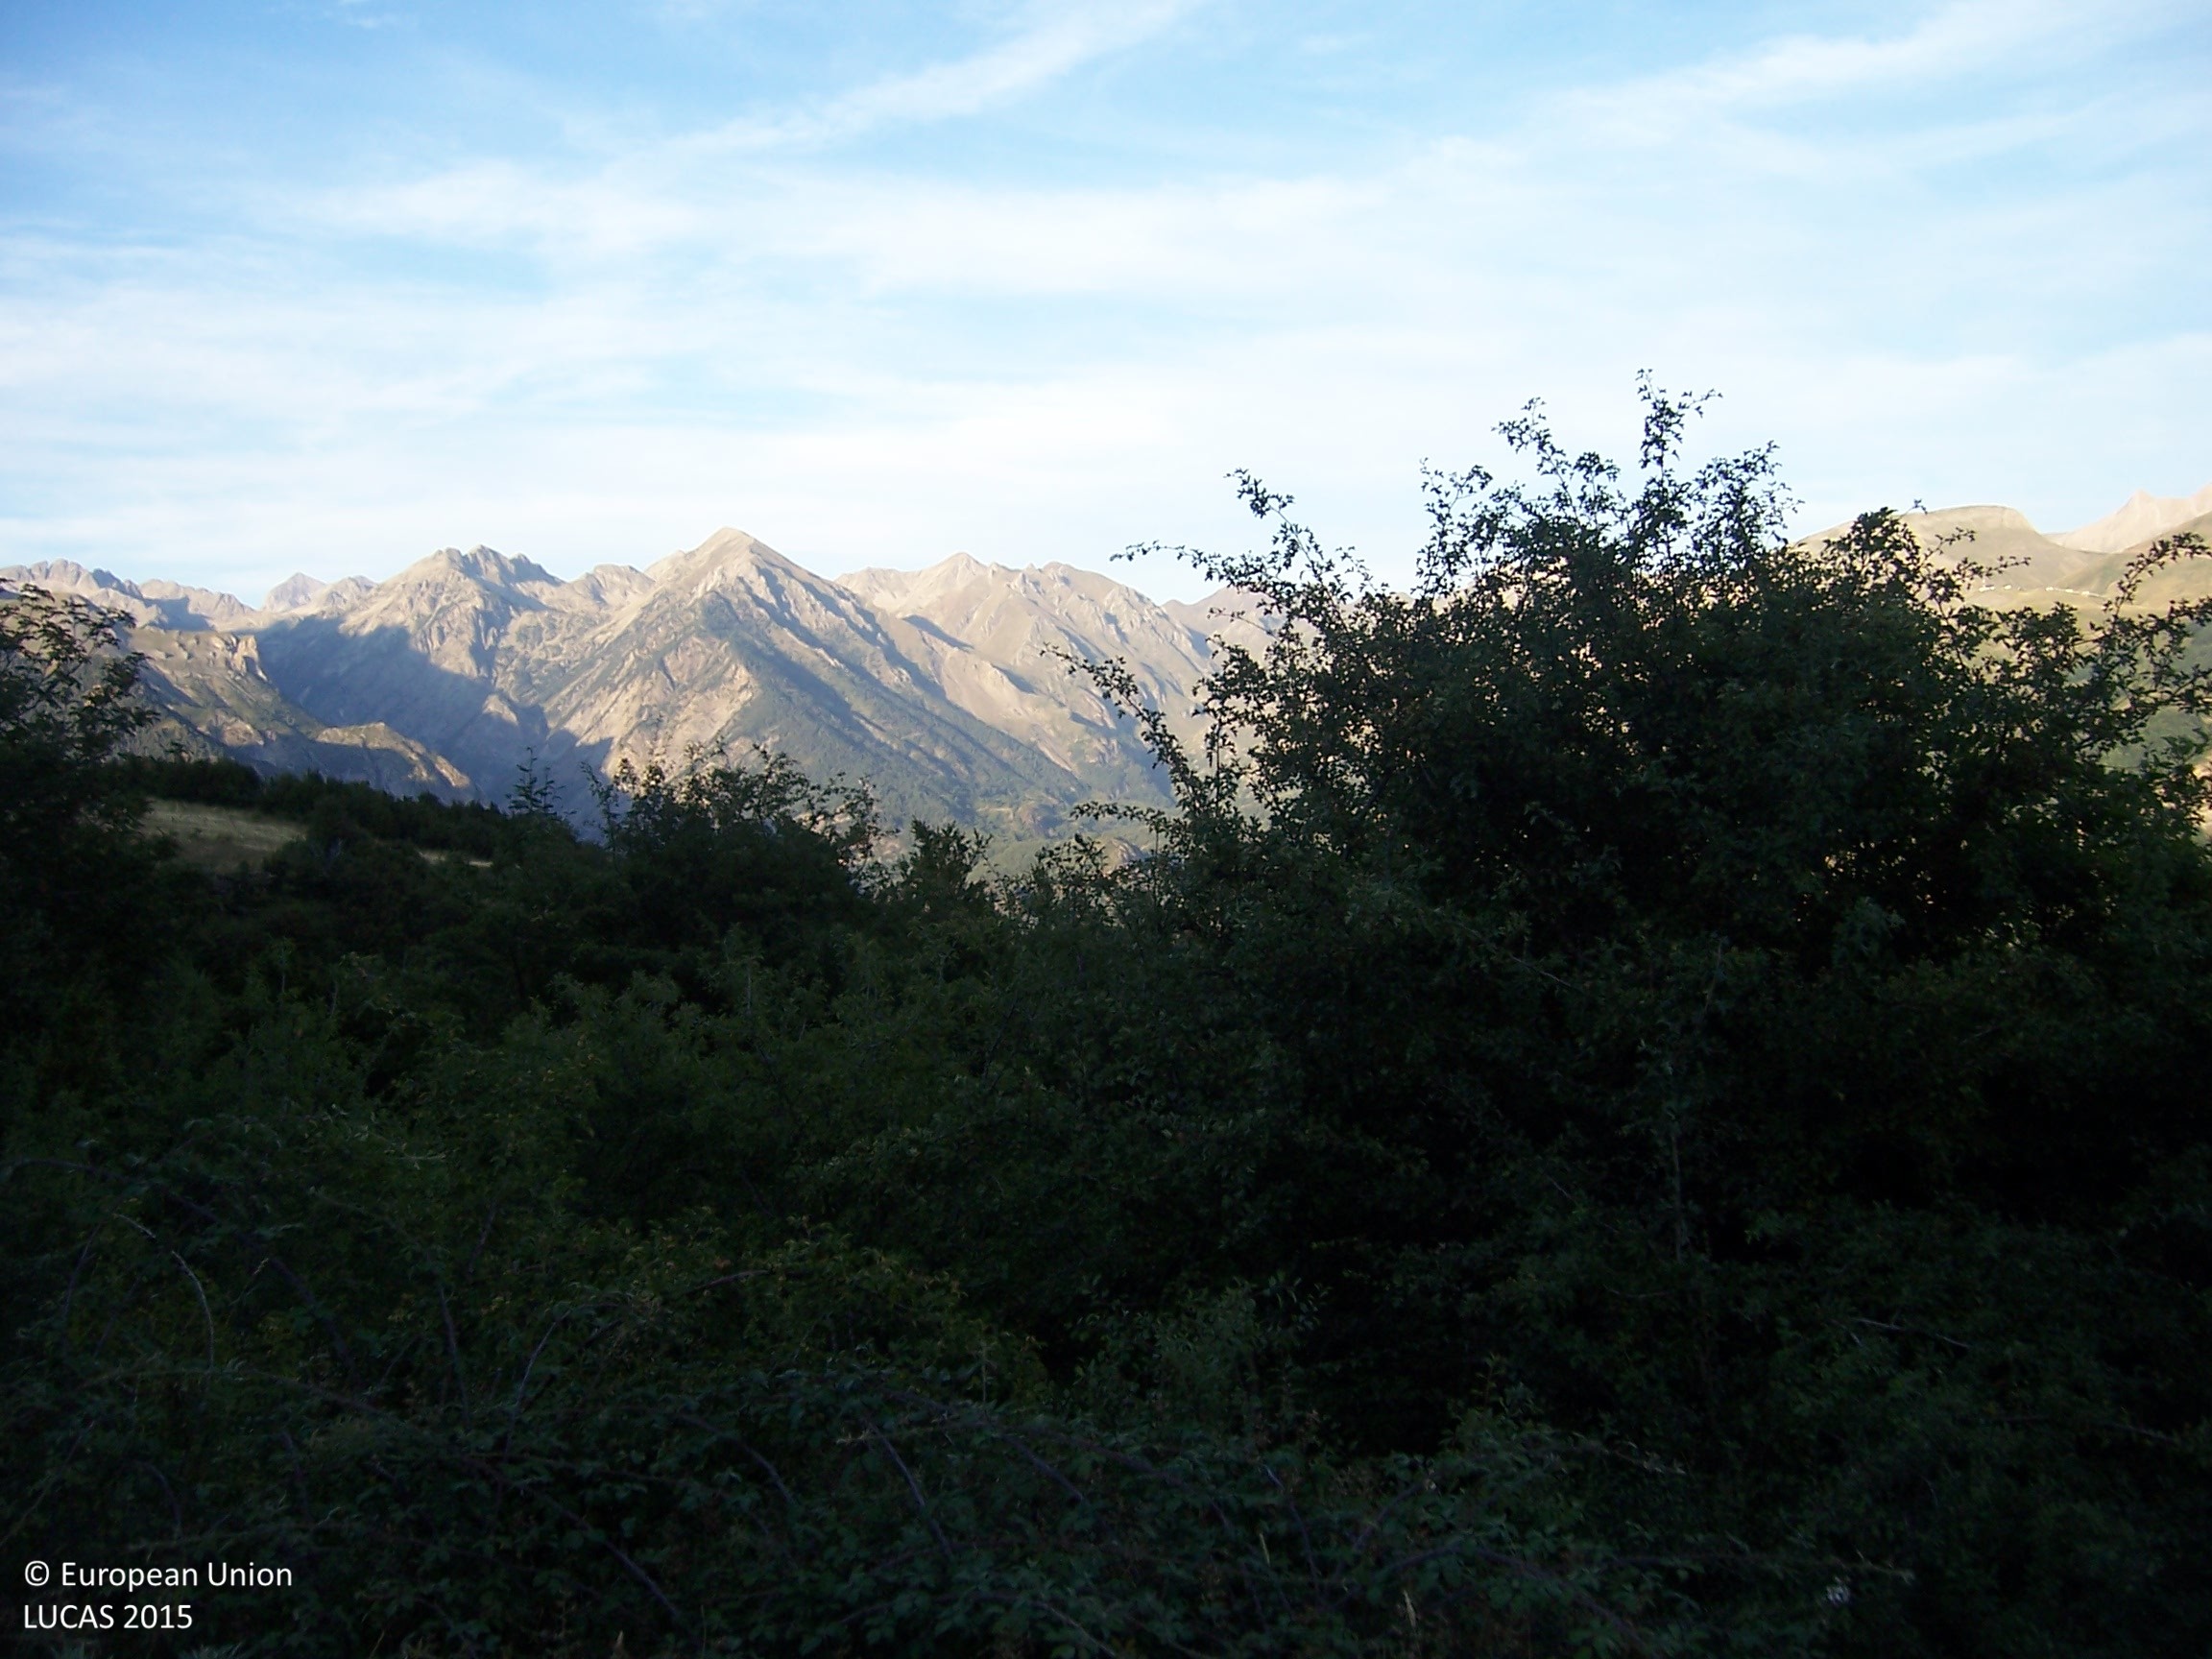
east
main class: Grassland
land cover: Grassland without tree/shrub cover
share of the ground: > 75 %
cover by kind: herbaceous plants 60 %, consolidated bare surface 40 %
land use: Agriculture (excluding fallow land and kitchen gardens)
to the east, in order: Grassland without tree/shrub cover; Rocks and stones; Grassland without tree/shrub cover; Rivers and streams; Grassland without tree/shrub cover; Tracks; Grassland without tree/shrub cover
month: August
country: ES
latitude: 42.7385
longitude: -0.3733
